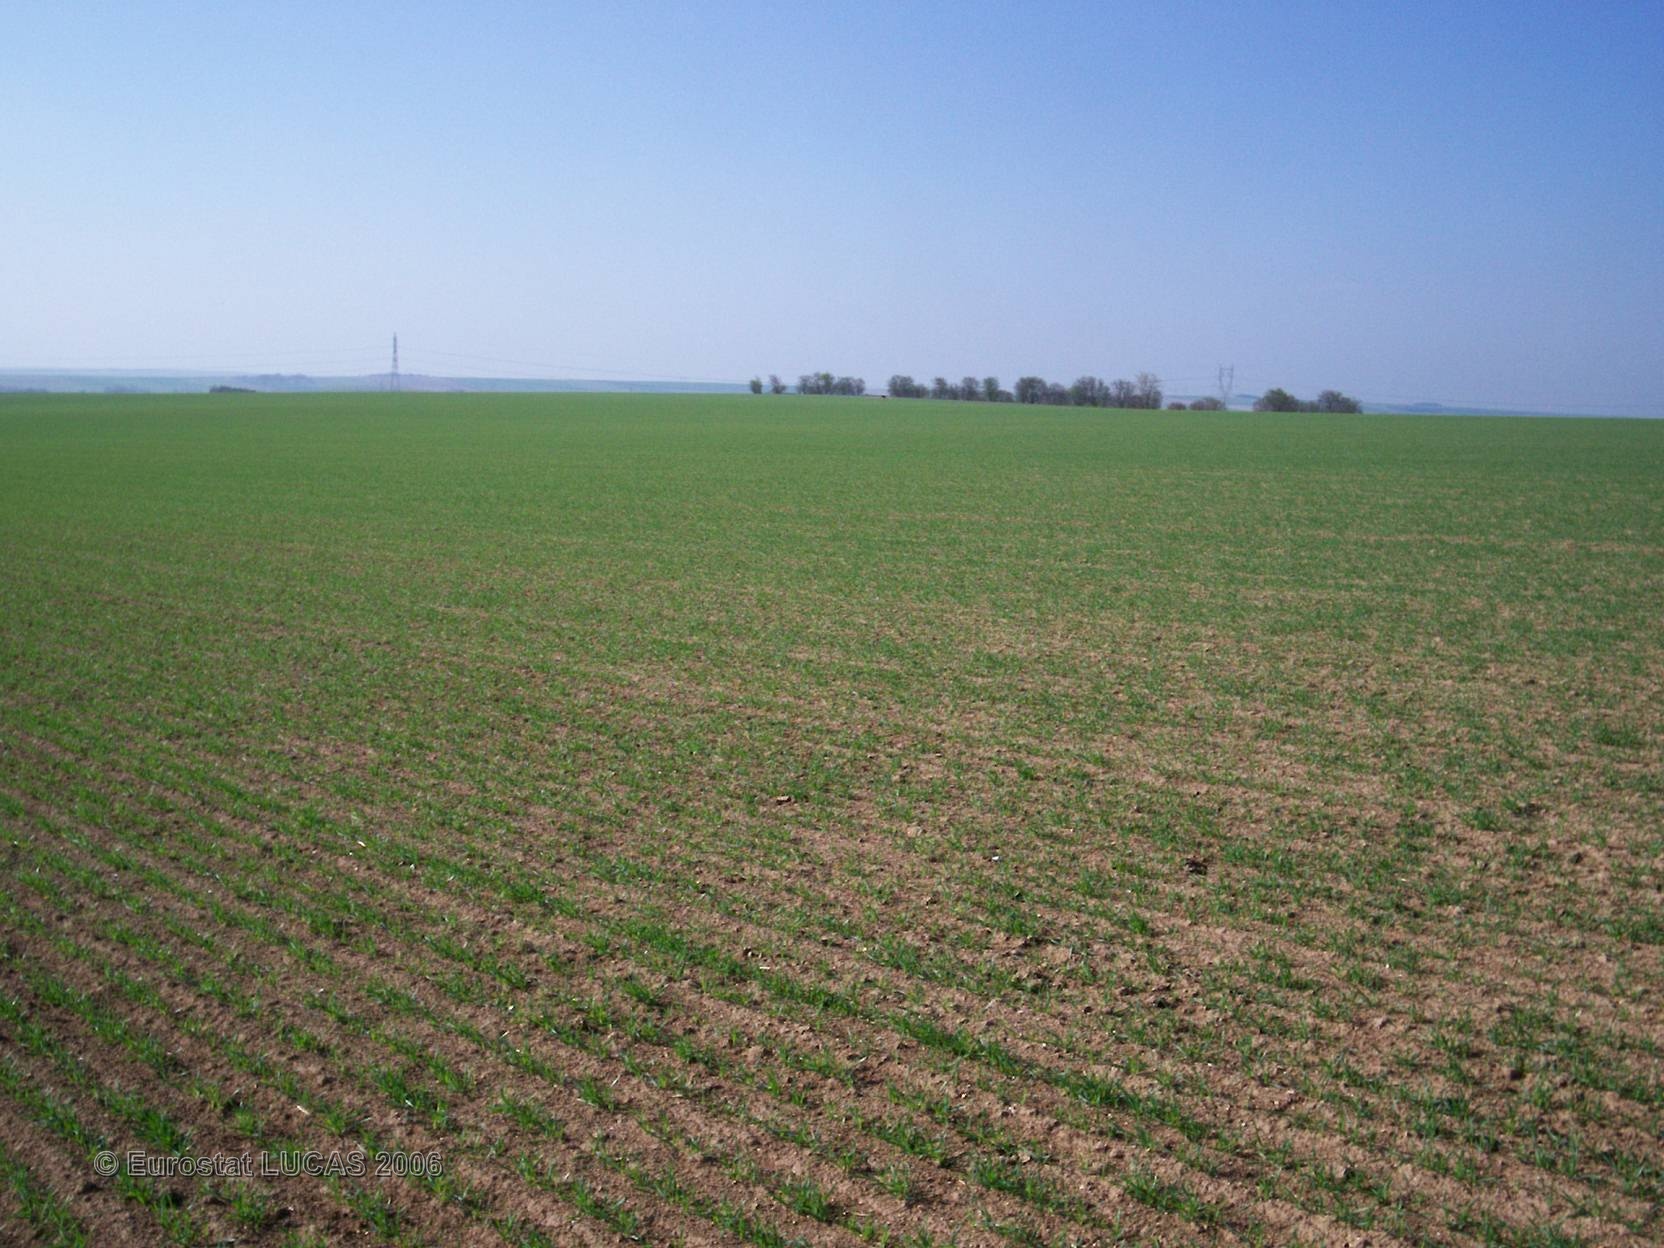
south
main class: Cropland
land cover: Barley
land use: Agriculture (excluding fallow land and kitchen gardens)
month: April
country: FR
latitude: 48.5337
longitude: 4.4310
